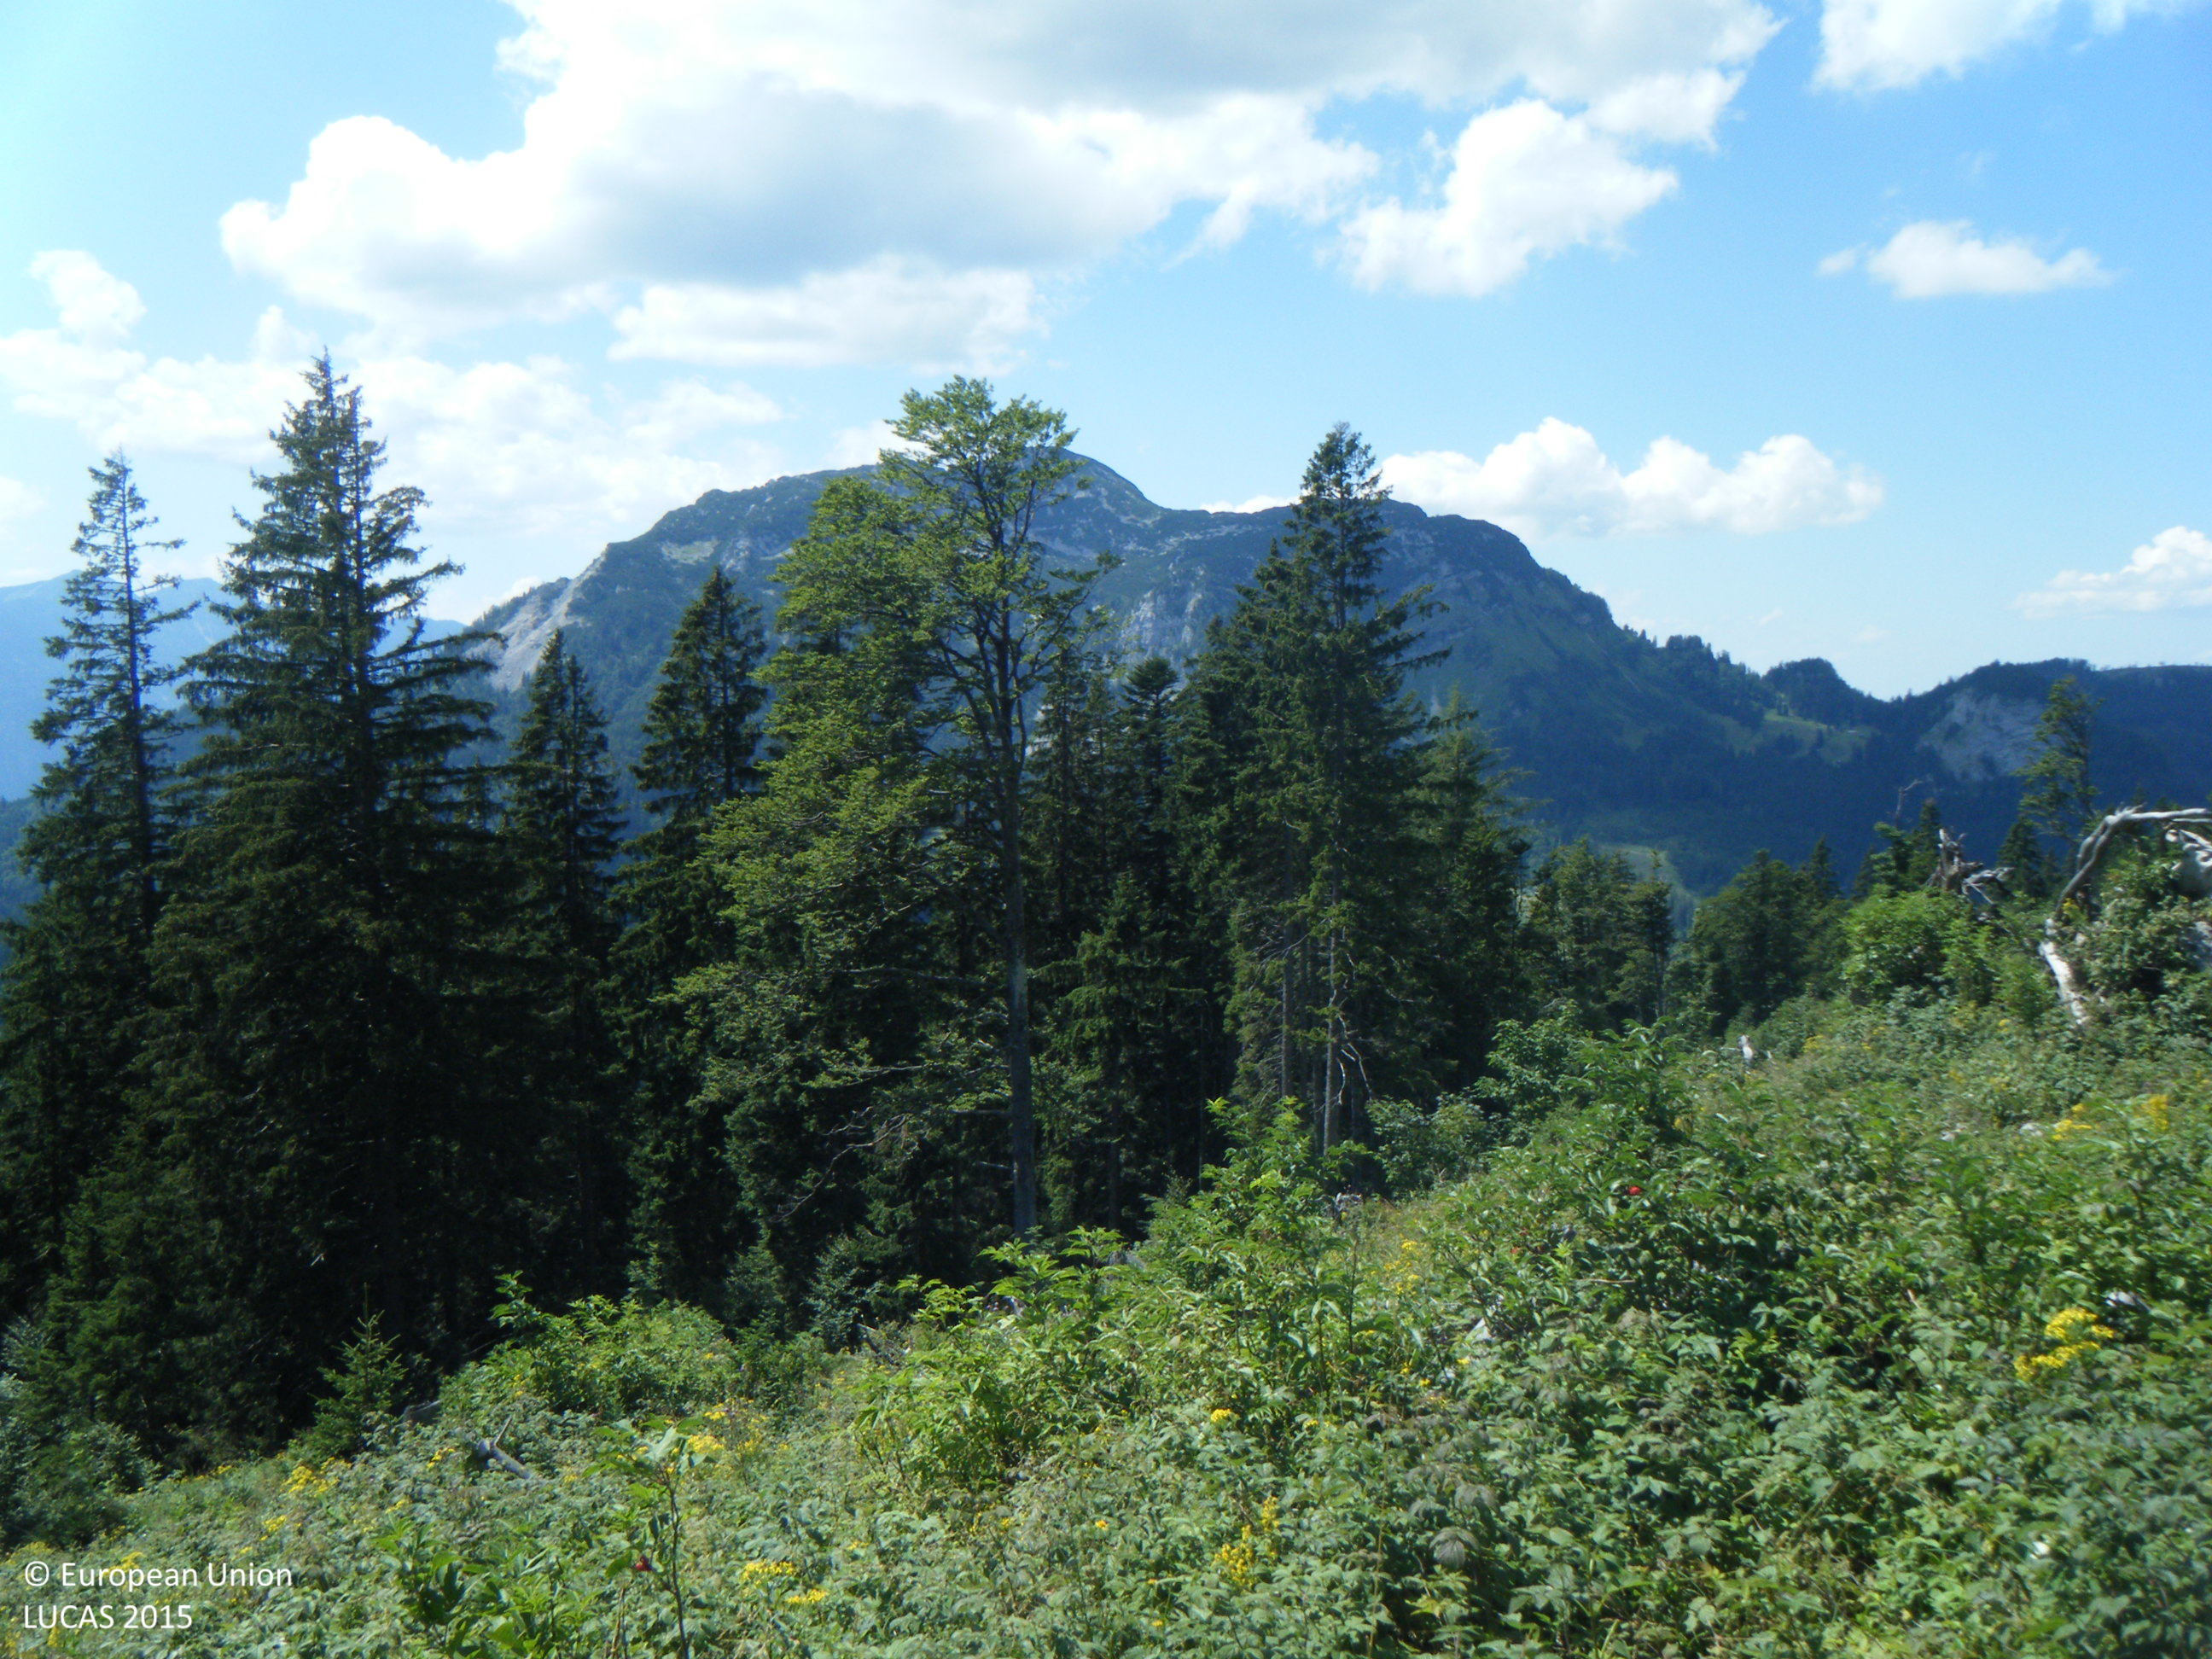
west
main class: Shrubland
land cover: Shrubland with sparse tree cover
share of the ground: 50 - 75 %
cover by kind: shrubs 65 %, herbaceous plants 30 %, broadleaved forest trees 5 %
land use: Forestry
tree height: < 5 m
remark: Clear cut
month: July
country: AT
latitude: 47.6548
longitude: 13.7667
